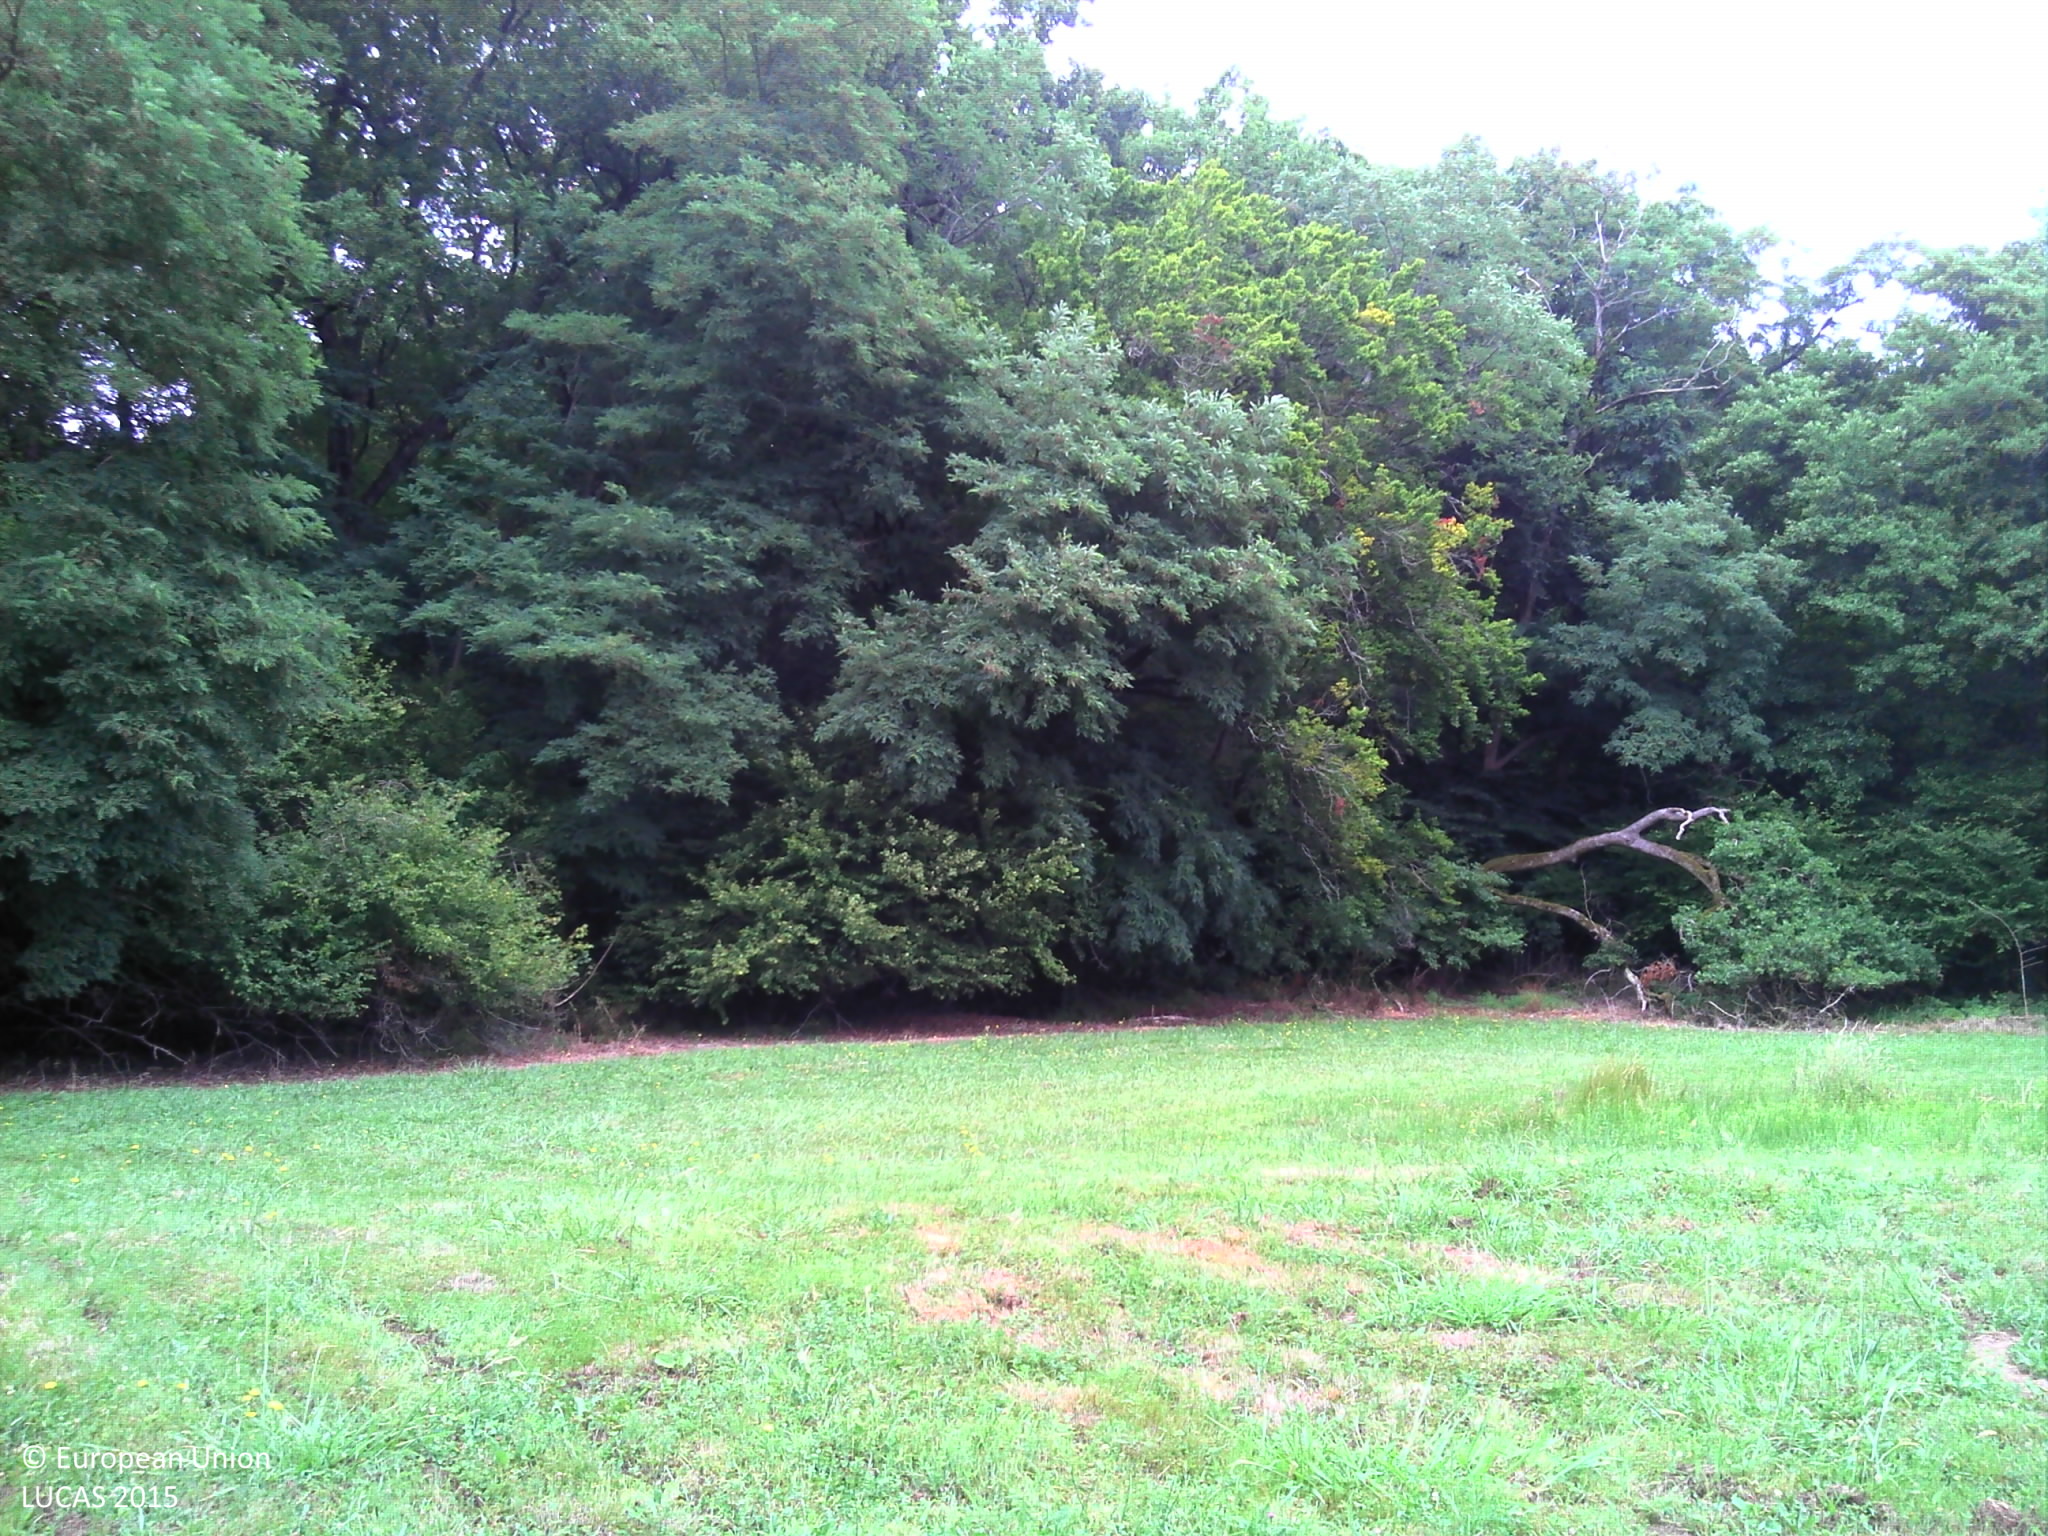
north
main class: Grassland
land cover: Grassland without tree/shrub cover
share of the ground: > 75 %
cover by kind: herbaceous plants 95 %, lichens and mosses 5 %
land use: Residential
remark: Clear cut
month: July
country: FR
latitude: 43.5554
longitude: -1.2440
